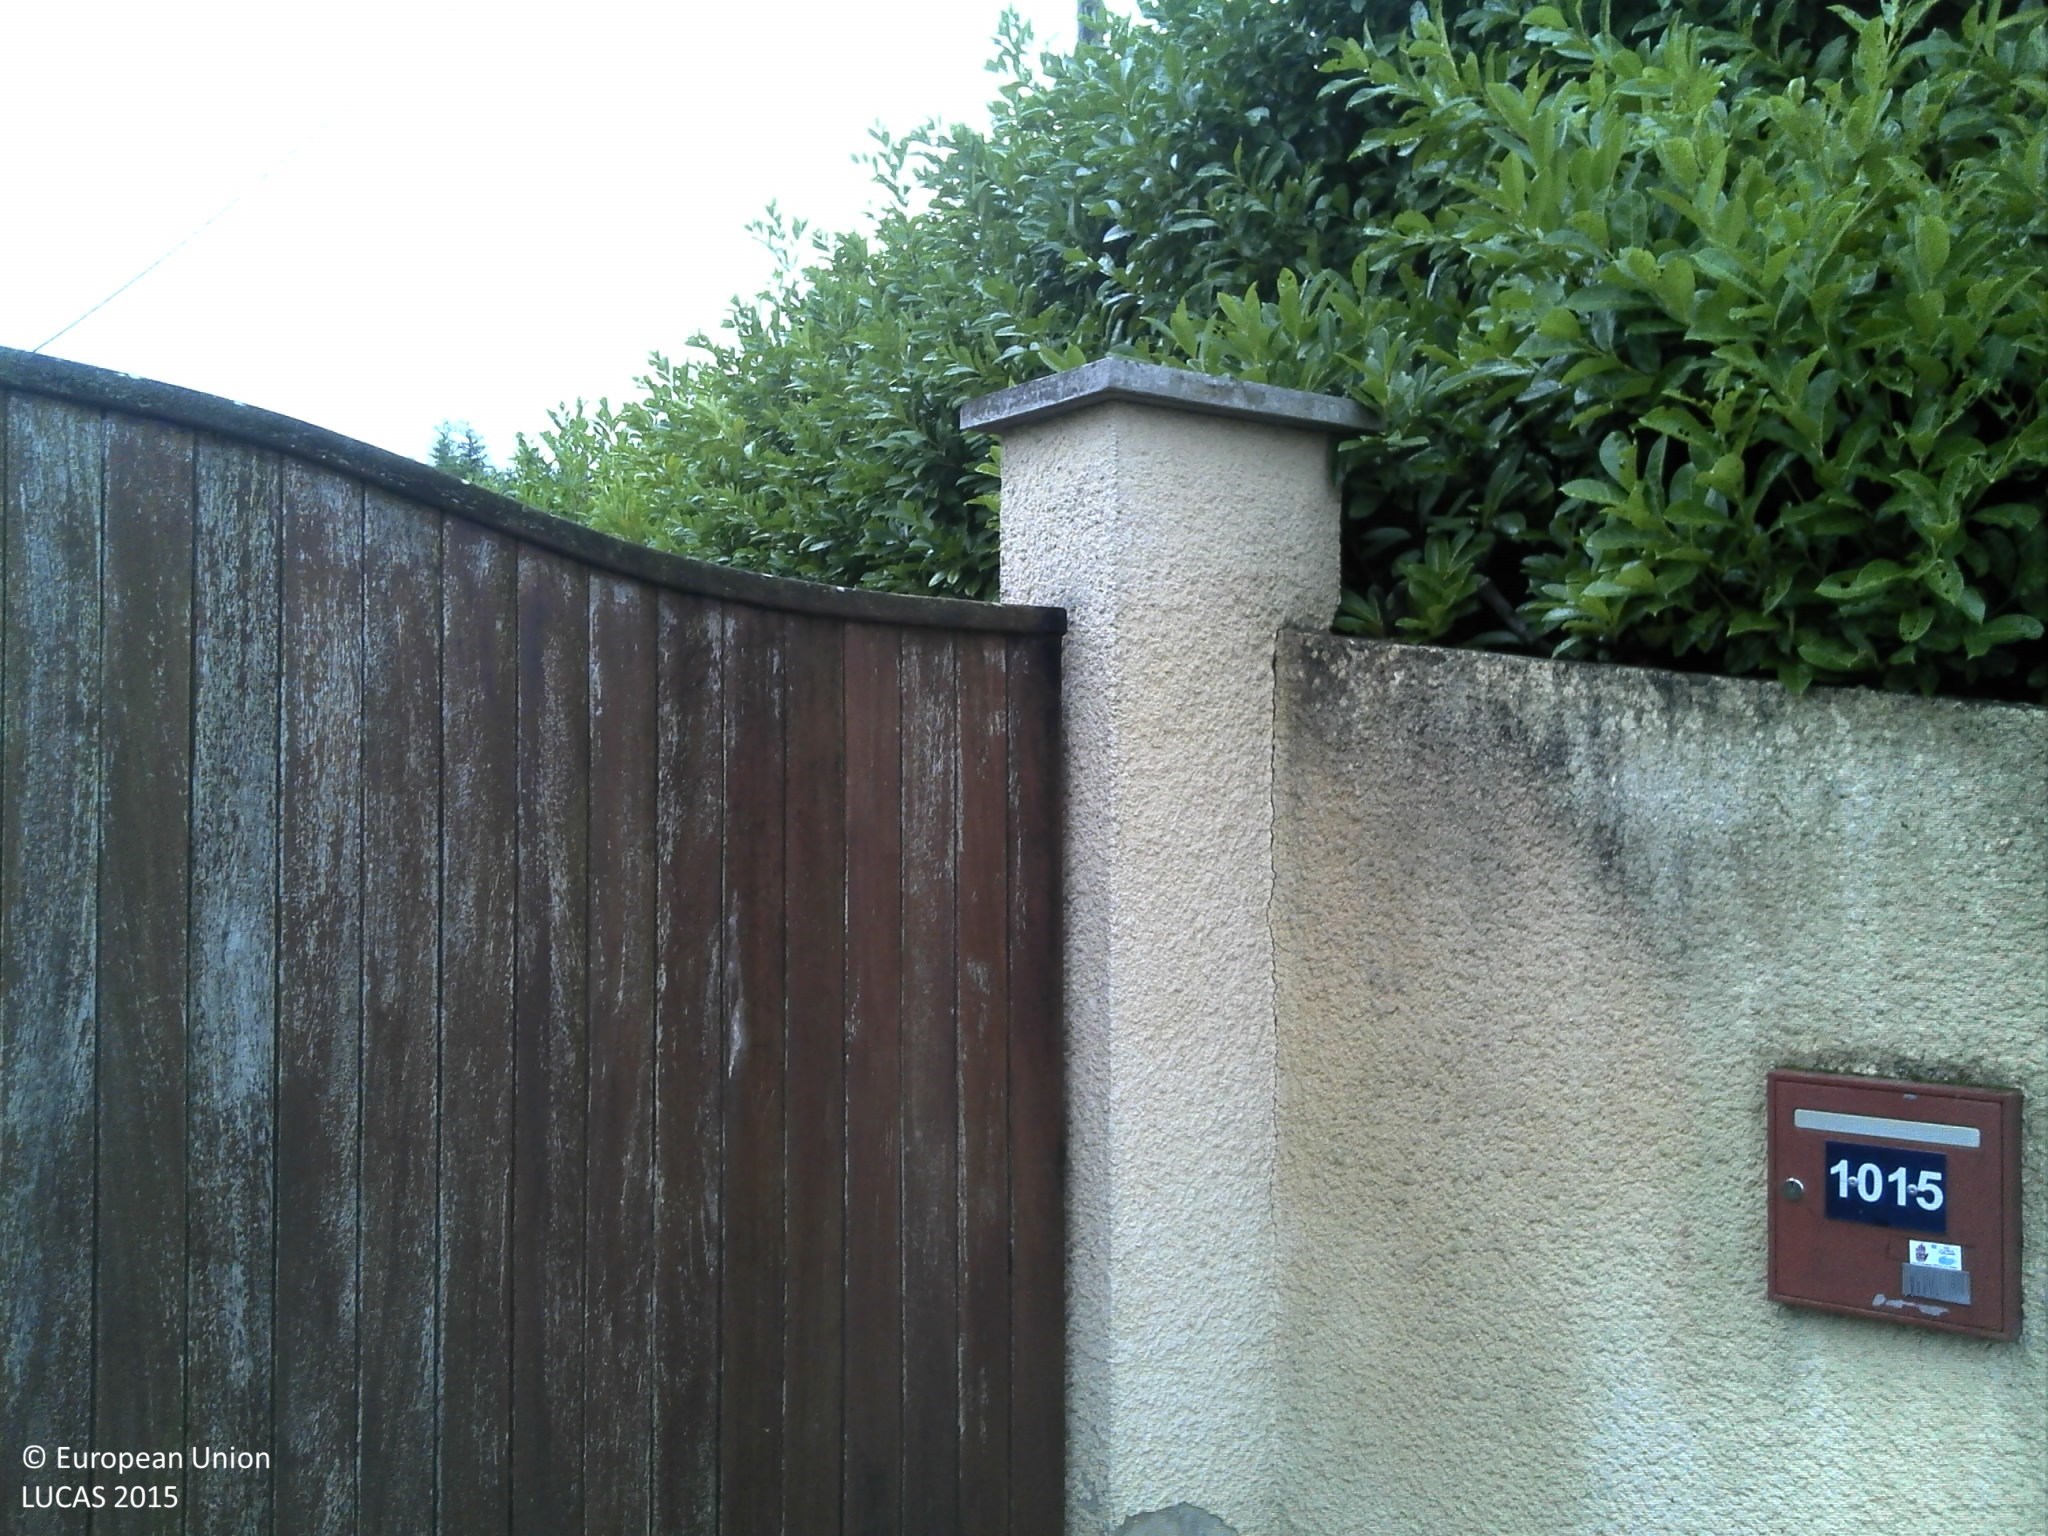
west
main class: Grassland
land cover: Grassland with sparse tree/shrub cover
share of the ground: > 75 %
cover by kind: herbaceous plants 95 %, broadleaved forest trees 5 %
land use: Residential
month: August
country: FR
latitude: 44.7342
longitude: -0.4089
